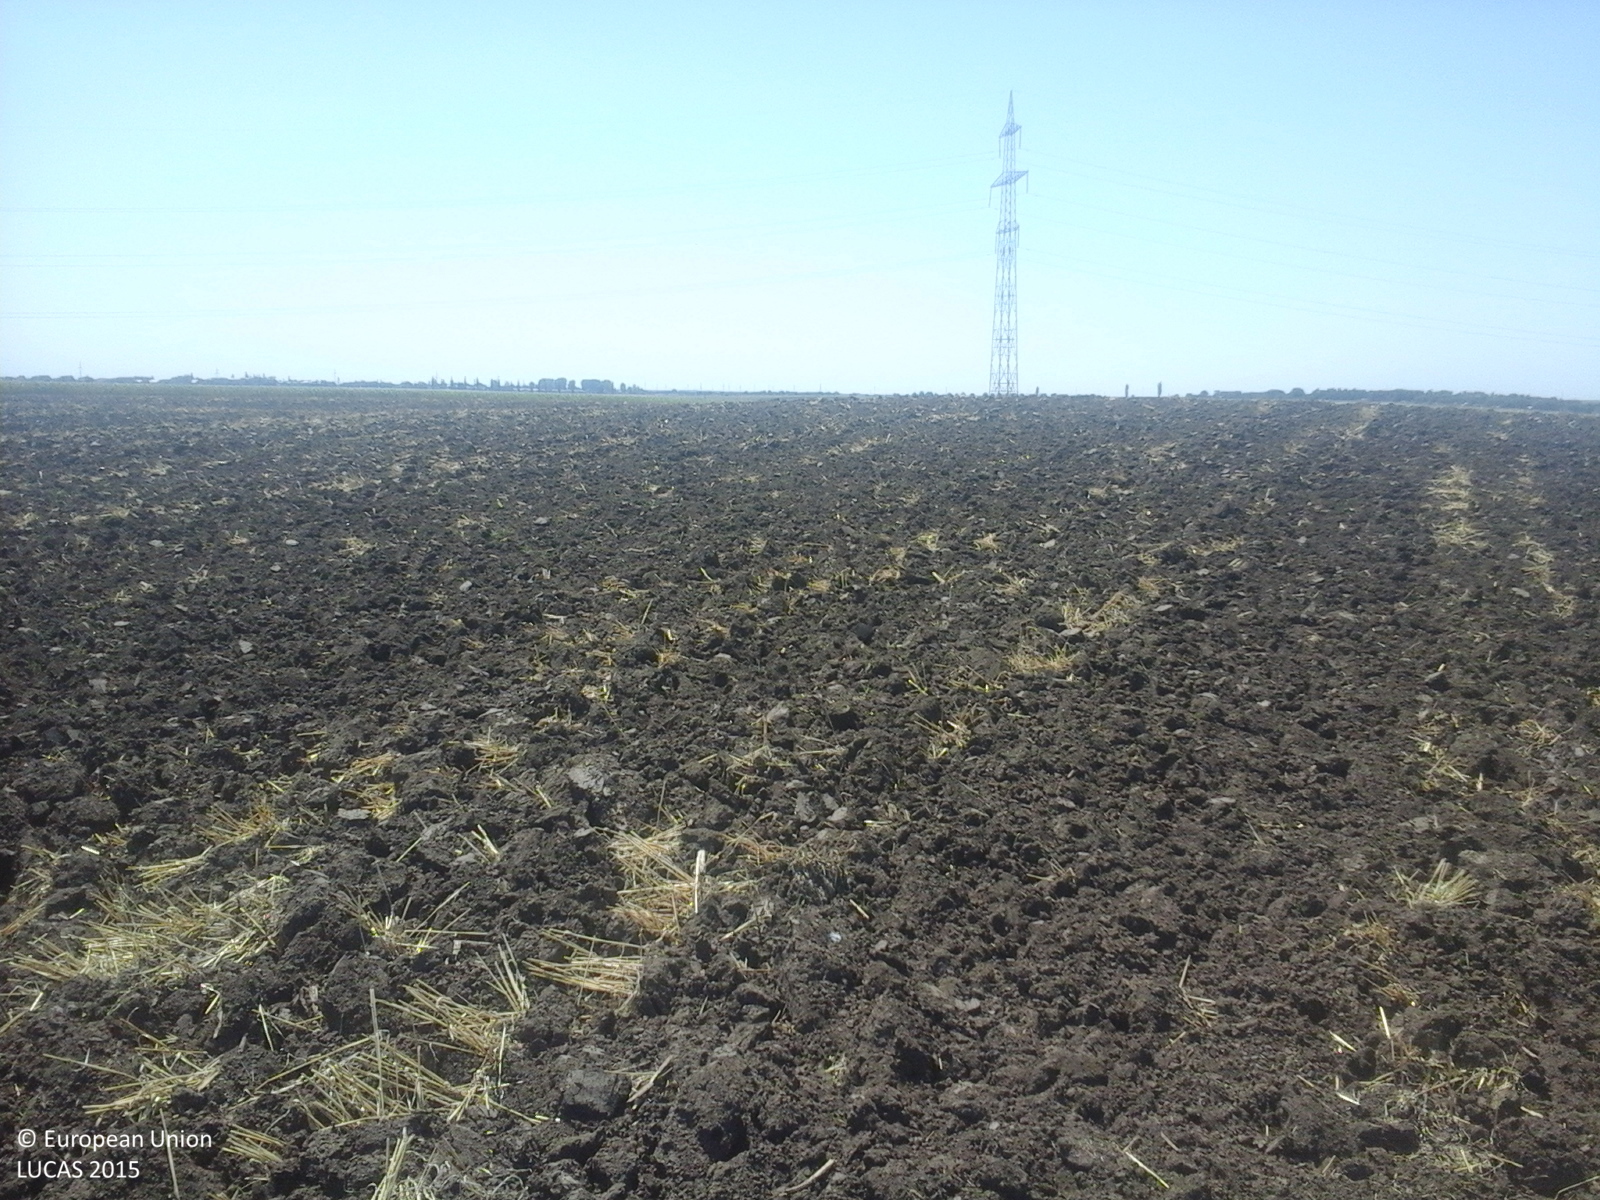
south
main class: Cropland
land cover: Durum wheat
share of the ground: < 10 %
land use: Agriculture (excluding fallow land and kitchen gardens)
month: July
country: RO
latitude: 44.4044
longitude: 26.6813
